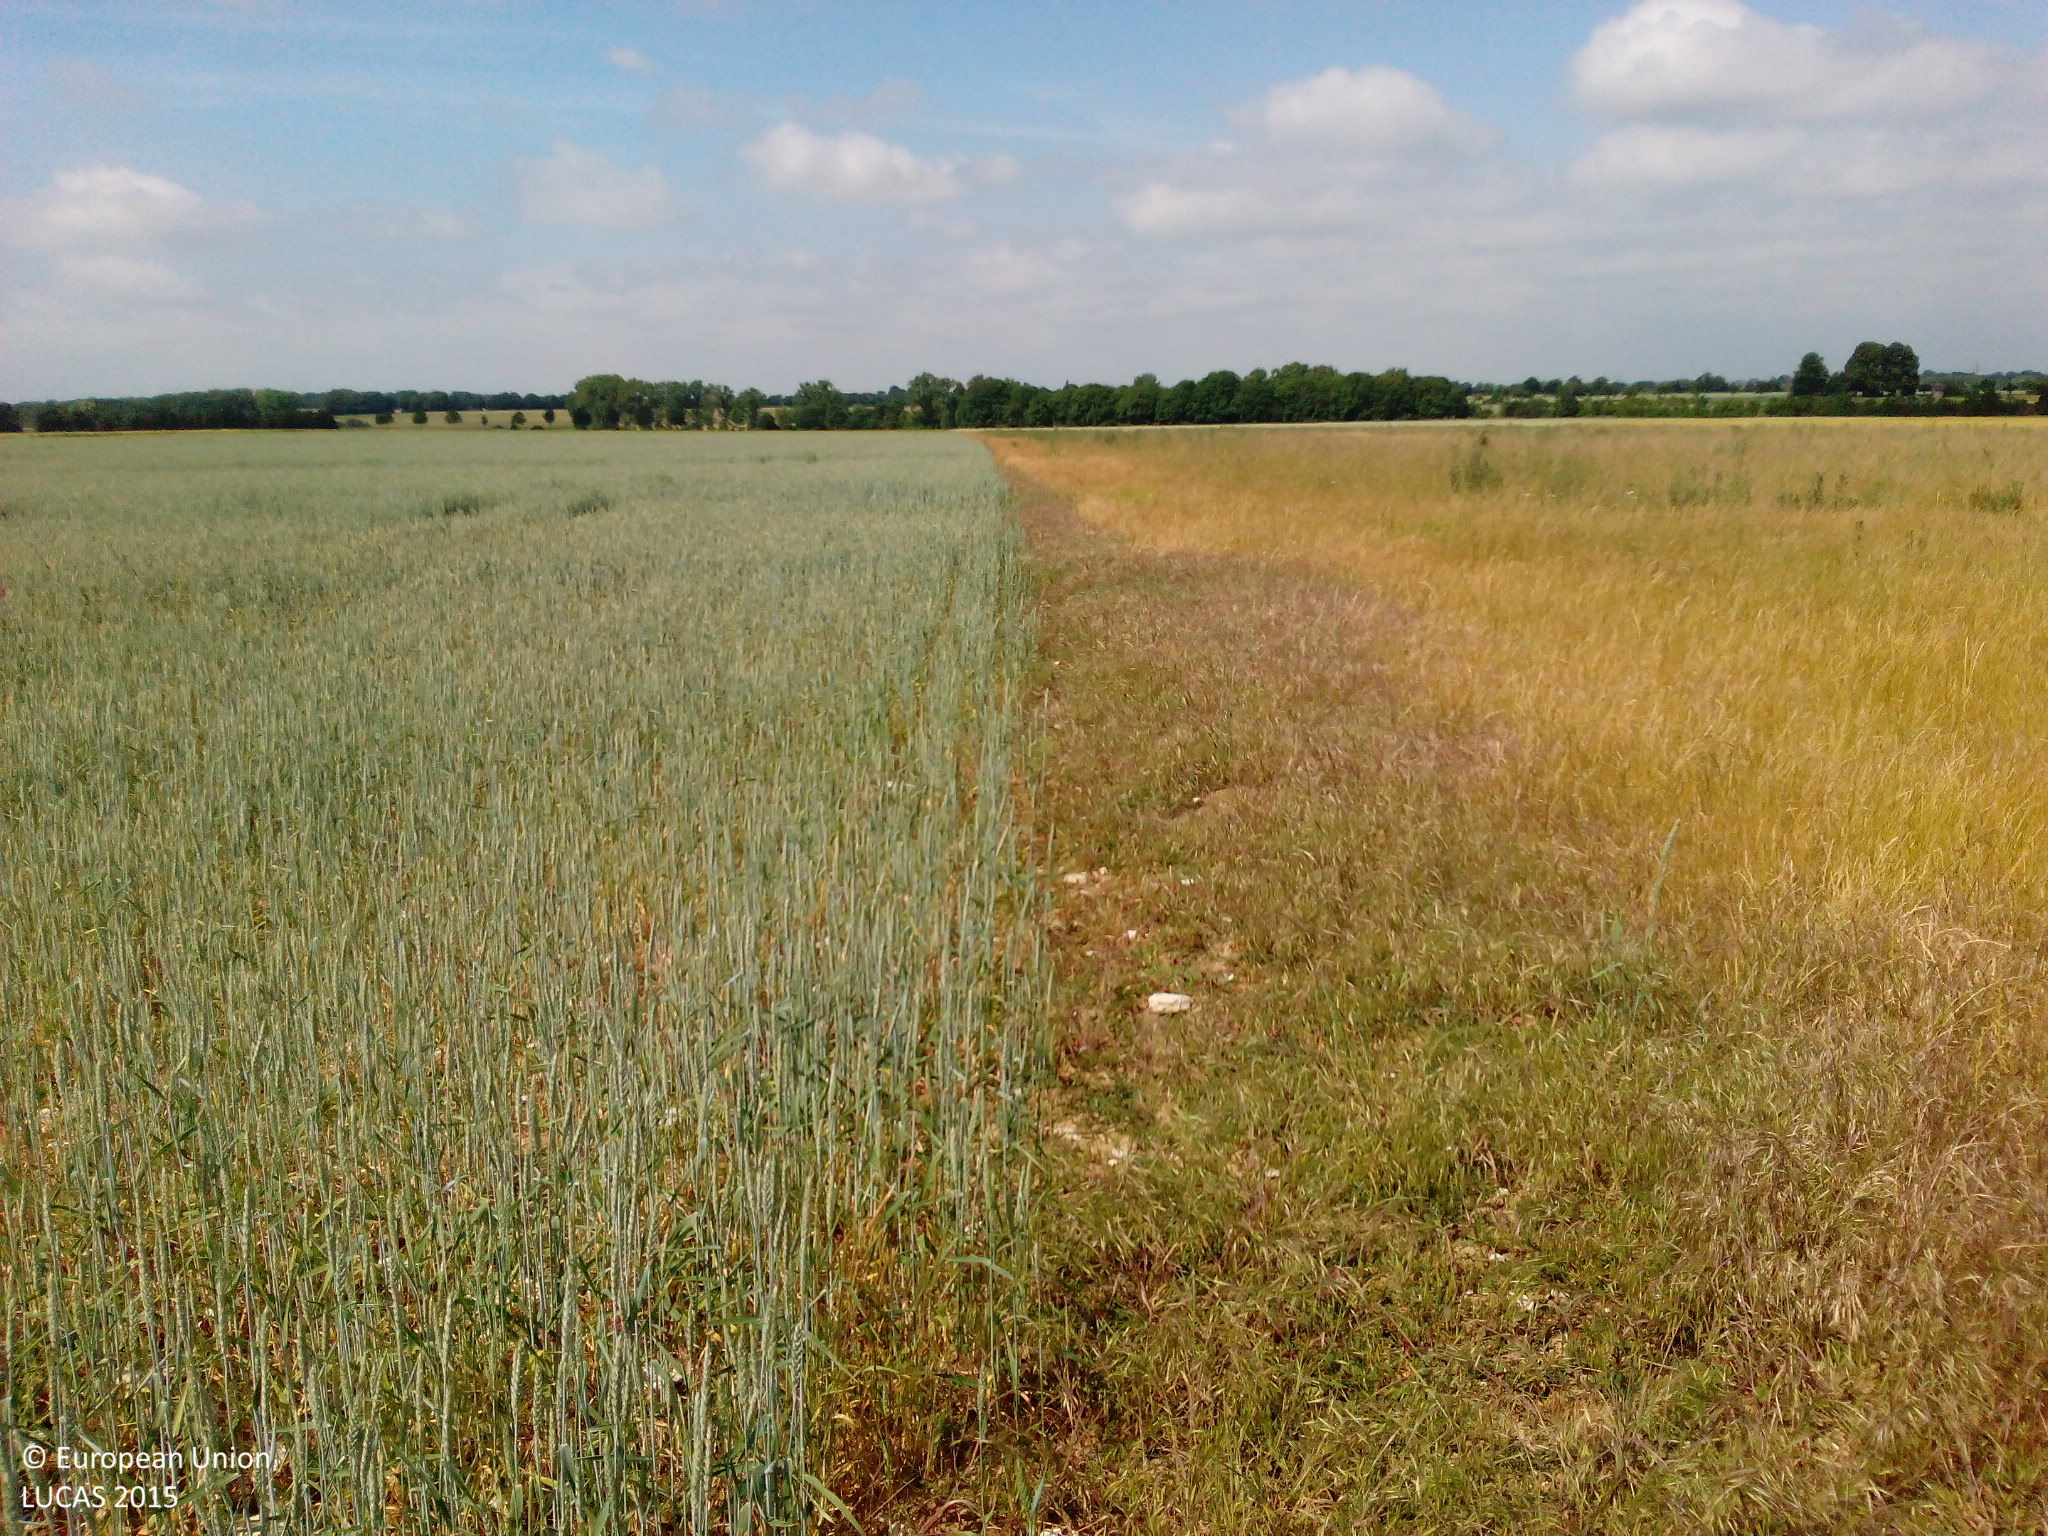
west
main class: Cropland
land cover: Barley
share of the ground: > 75 %
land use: Agriculture (excluding fallow land and kitchen gardens)
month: June
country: DE
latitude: 51.6123
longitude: 8.4552
